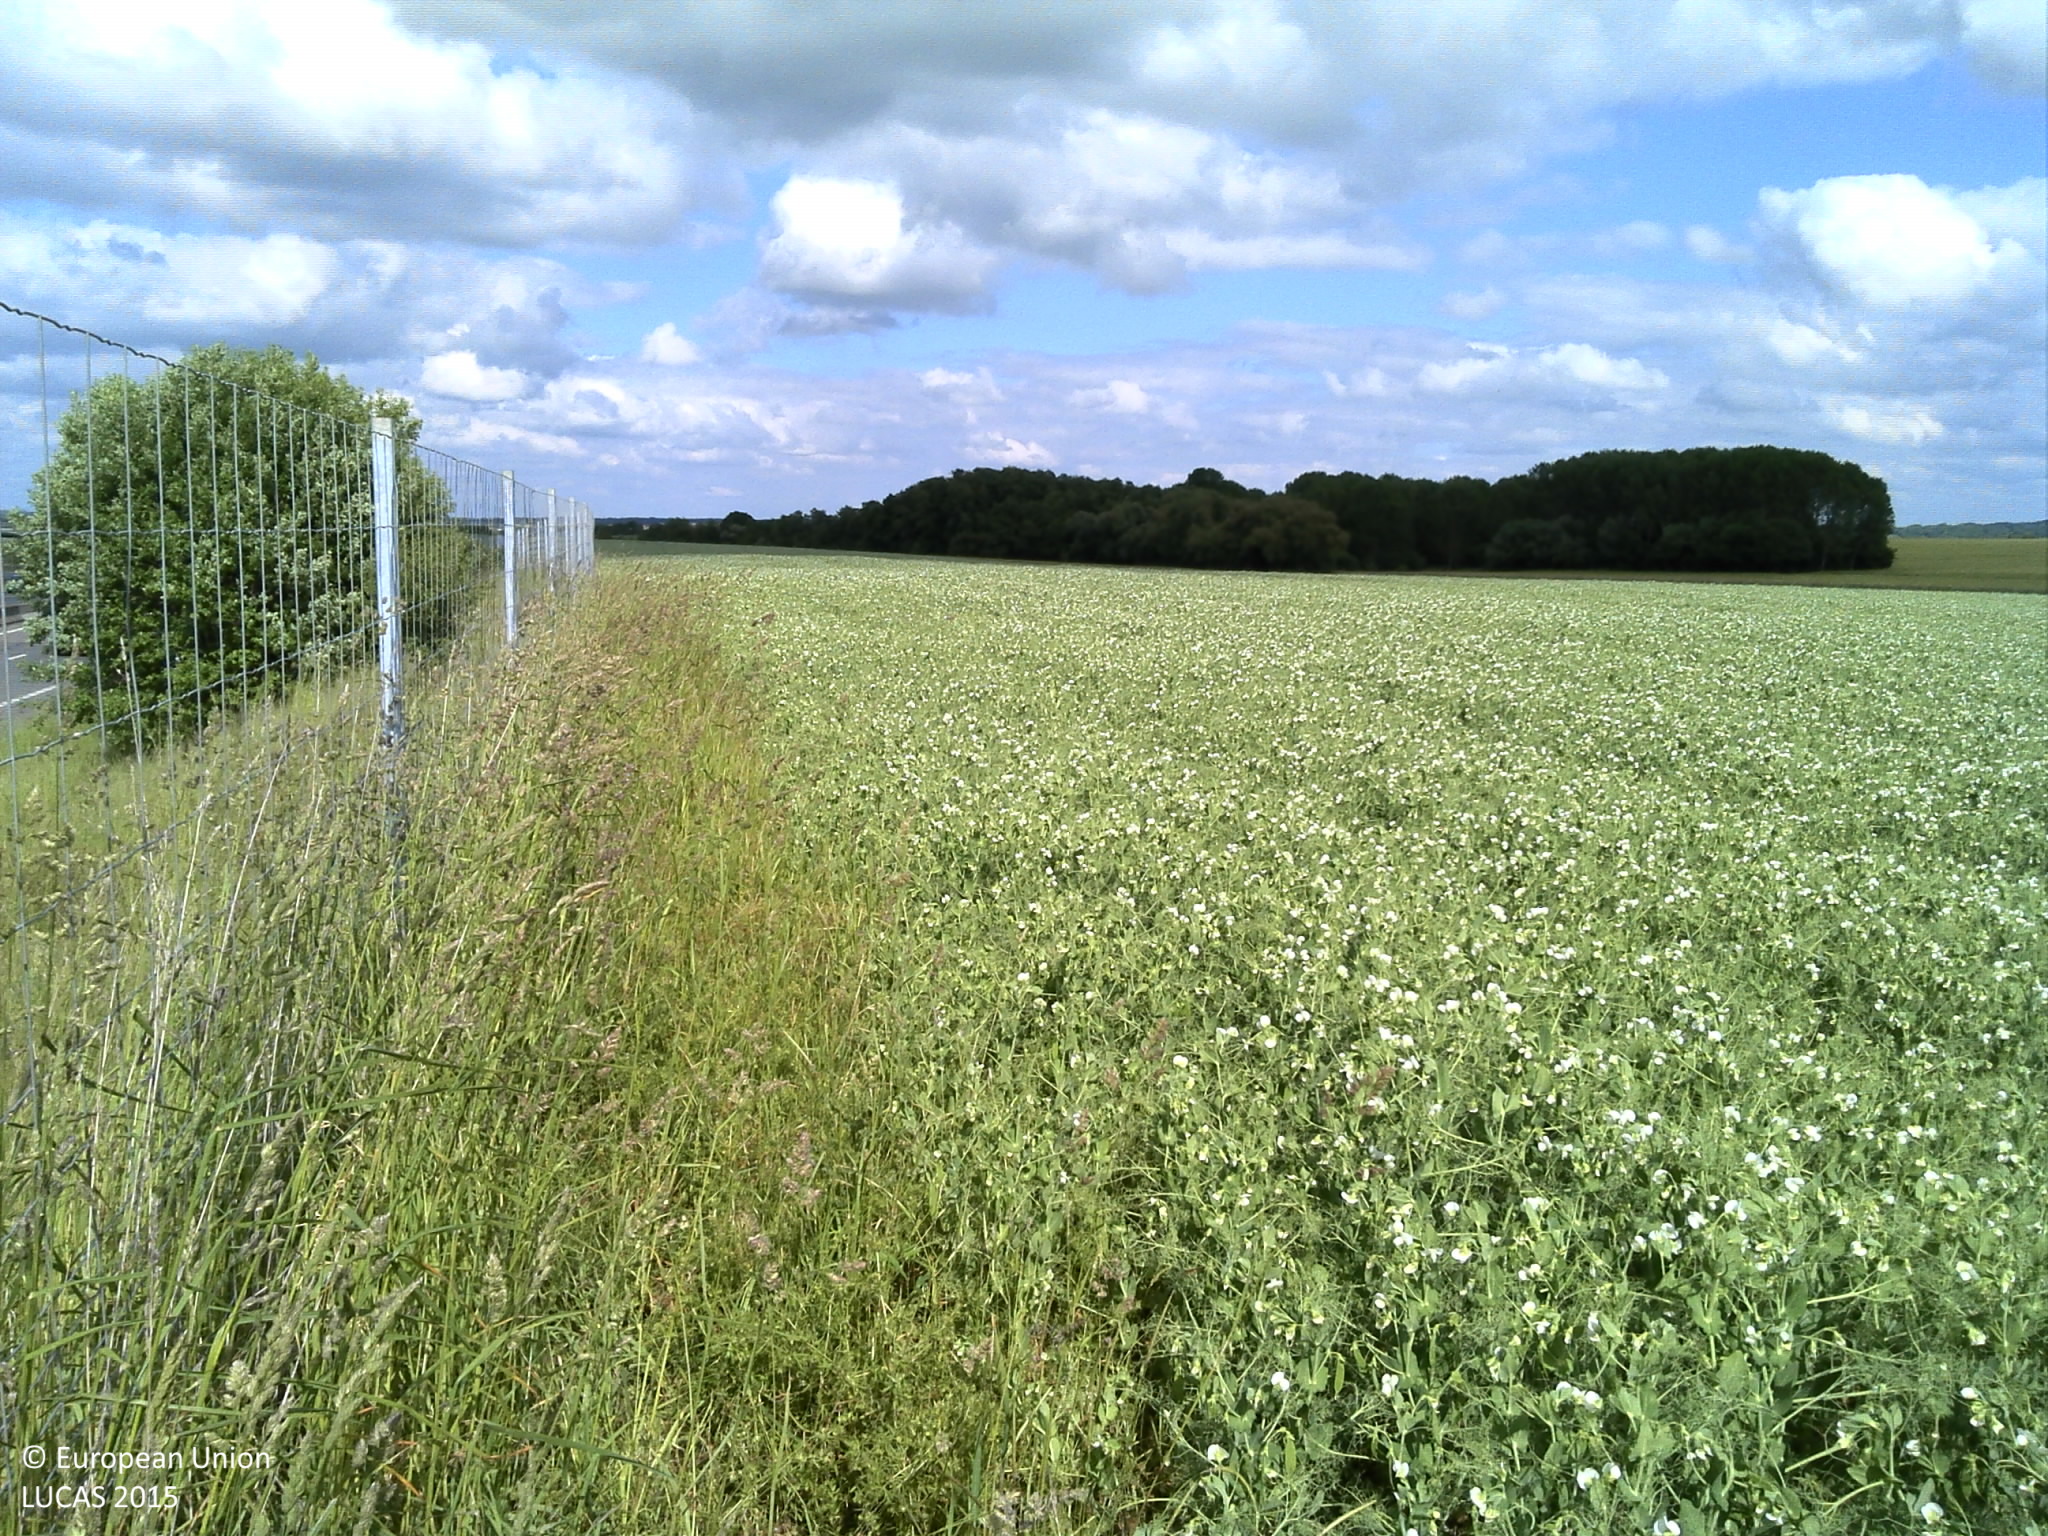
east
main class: Grassland
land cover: Grassland without tree/shrub cover
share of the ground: > 75 %
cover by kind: herbaceous plants 100 %
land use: Semi-natural and natural areas not in use
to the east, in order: Grassland without tree/shrub cover; Fences; Grass margins; Dry pulses
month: June
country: FR
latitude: 49.0382
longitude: 6.1285
